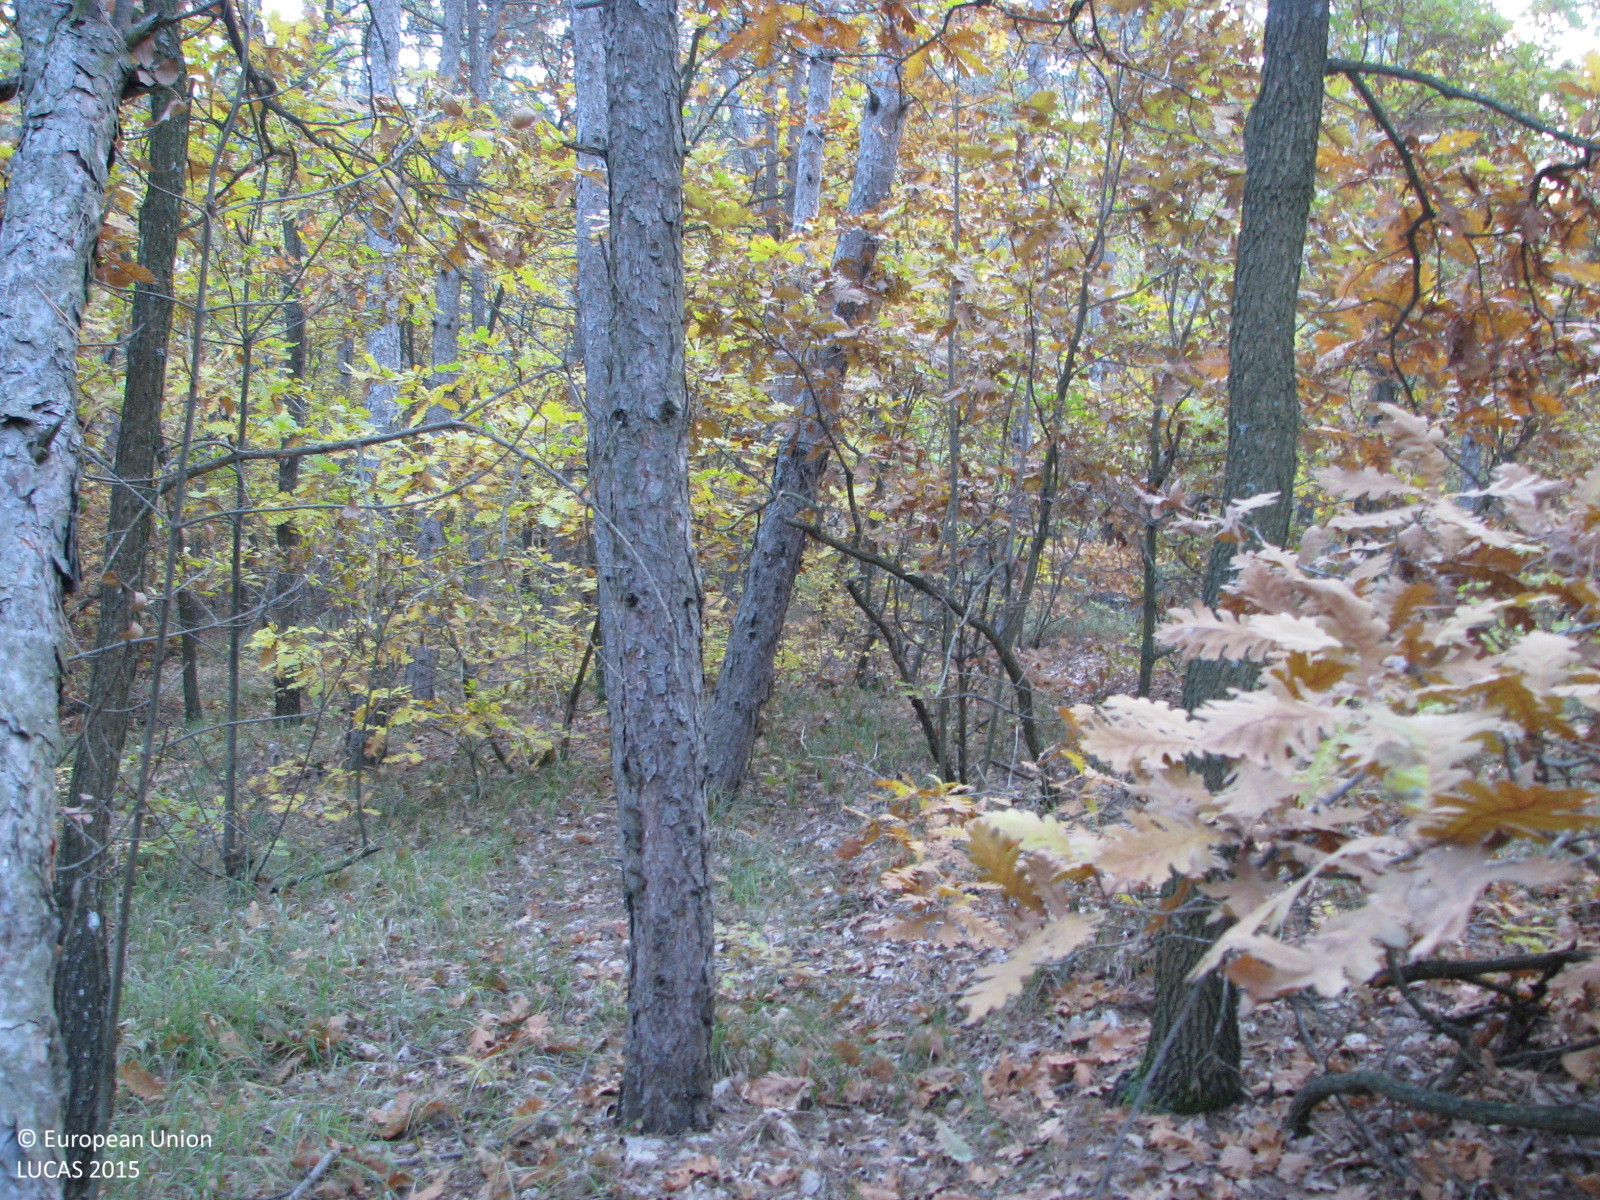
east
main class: Woodland
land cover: Pine dominated mixed woodland
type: hemiboreal forest and nemoral coniferous forest and mixed broadleaved-coniferous forest
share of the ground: 50 - 75 %
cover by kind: coniferous forest trees 40 %, herbaceous plants 30 %, broadleaved forest trees 20 %, shrubs 10 %
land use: Forestry
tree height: > 5 m
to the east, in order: Pine dominated mixed woodland; Grass margins; Tracks; Grass margins; Pine dominated mixed woodland; Tracks; Pine dominated mixed woodland; Tracks; Grass margins; Pine dominated mixed woodland
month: November
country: BG
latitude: 41.9730
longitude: 26.4850
